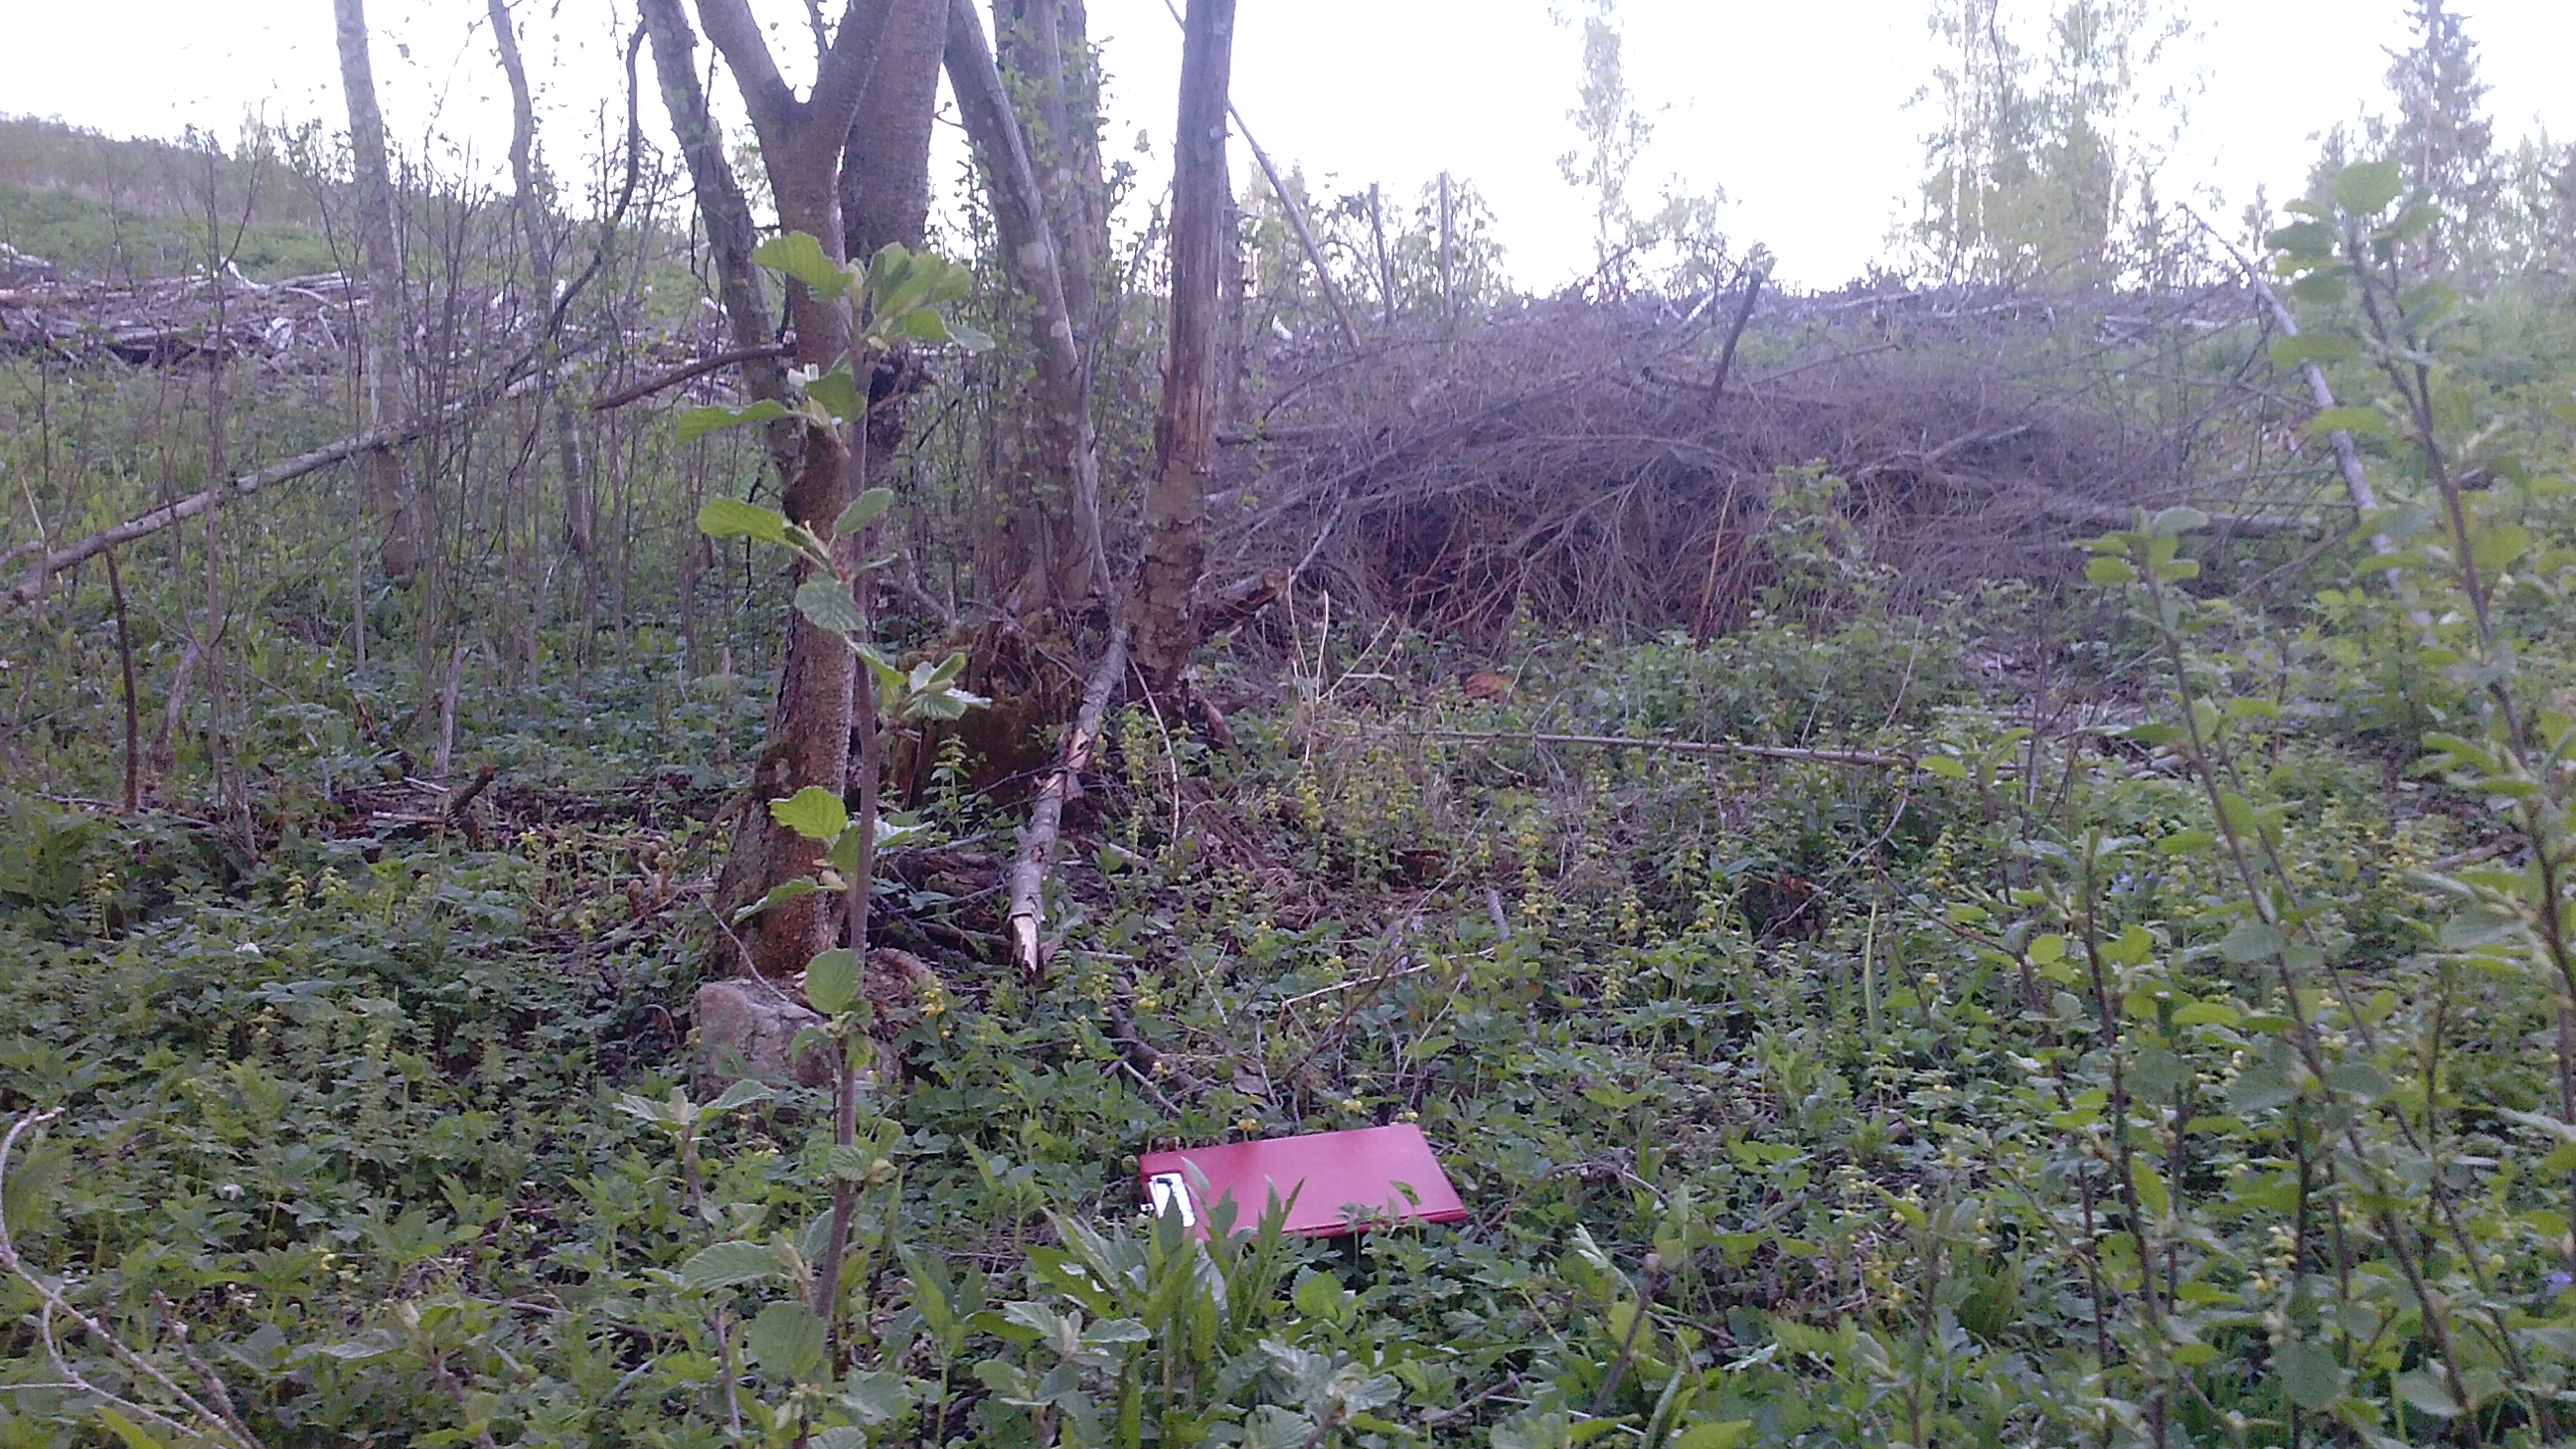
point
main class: Woodland
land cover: Broadleaved woodland
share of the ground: 50 - 75 %
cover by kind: broadleaved forest trees 50 %, shrubs 50 %
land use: Forestry
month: May
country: LV
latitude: 56.0707
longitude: 27.8143
